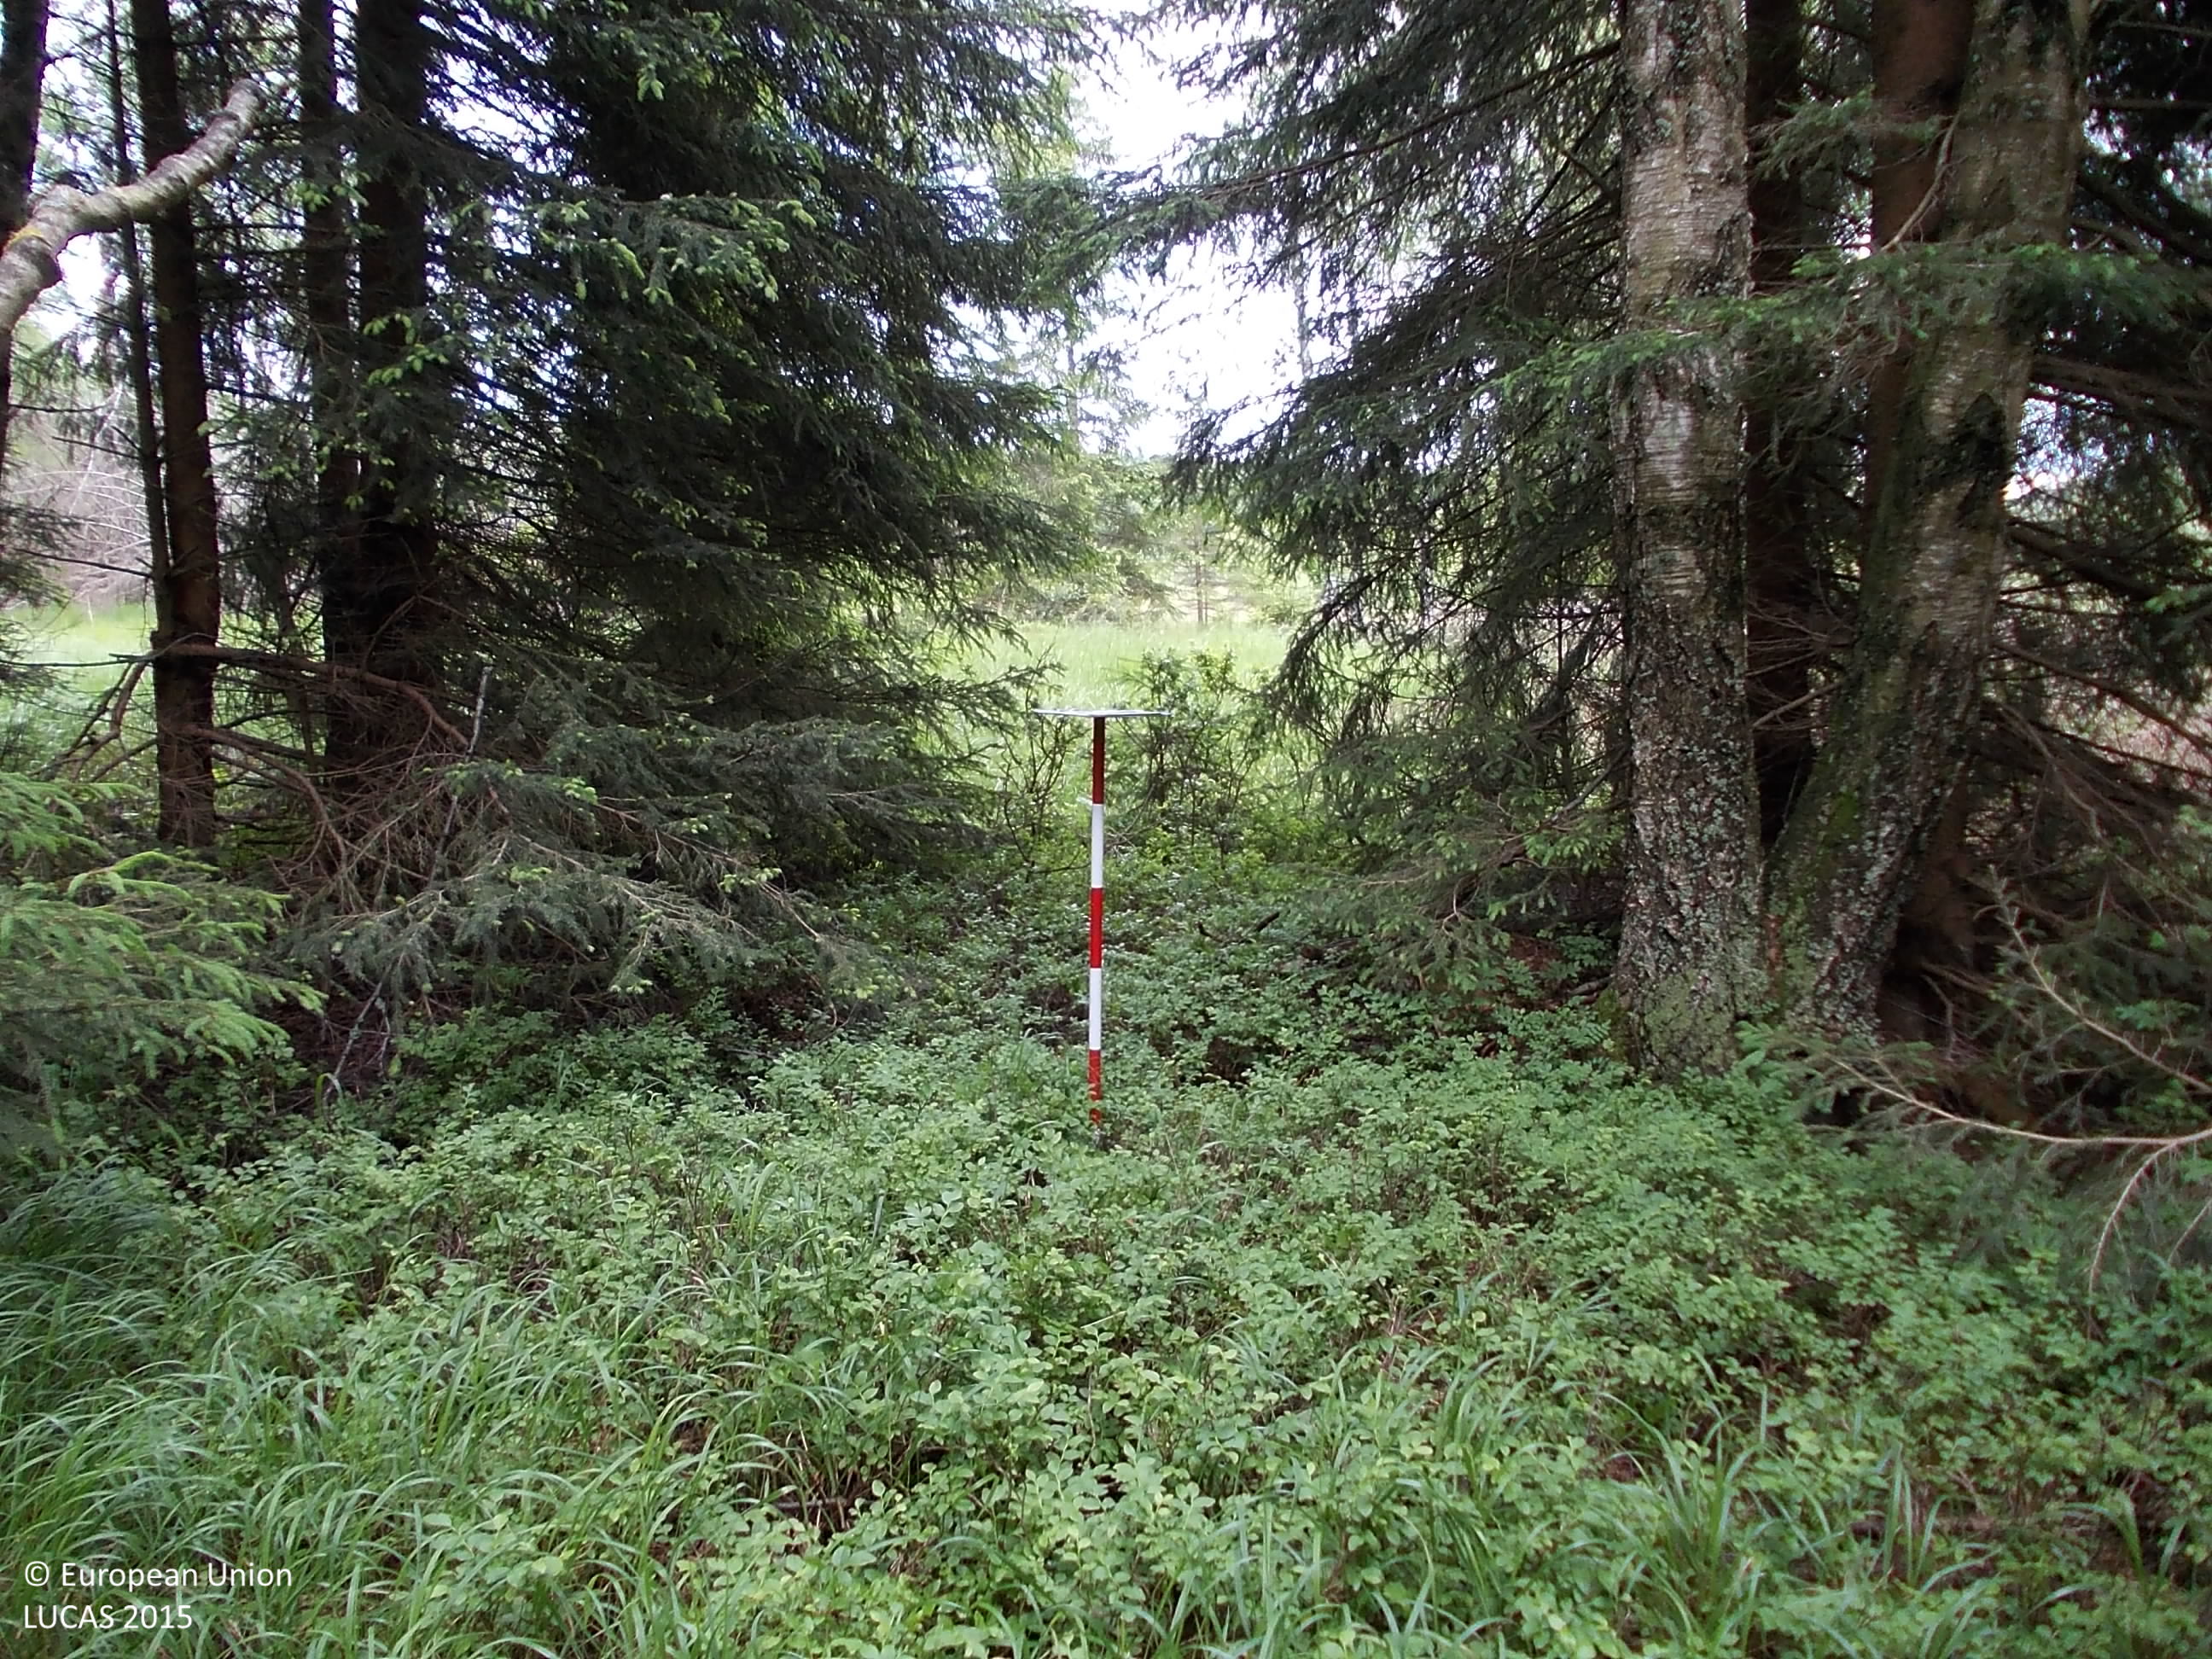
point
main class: Woodland
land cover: Spruce dominated mixed woodland
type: hemiboreal forest and nemoral coniferous forest and mixed broadleaved-coniferous forest
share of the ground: 50 - 75 %
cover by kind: coniferous forest trees 40 %, herbaceous plants 40 %, broadleaved forest trees 20 %
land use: Forestry
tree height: > 5 m
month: June
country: CZ
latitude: 48.8821
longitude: 13.6955
